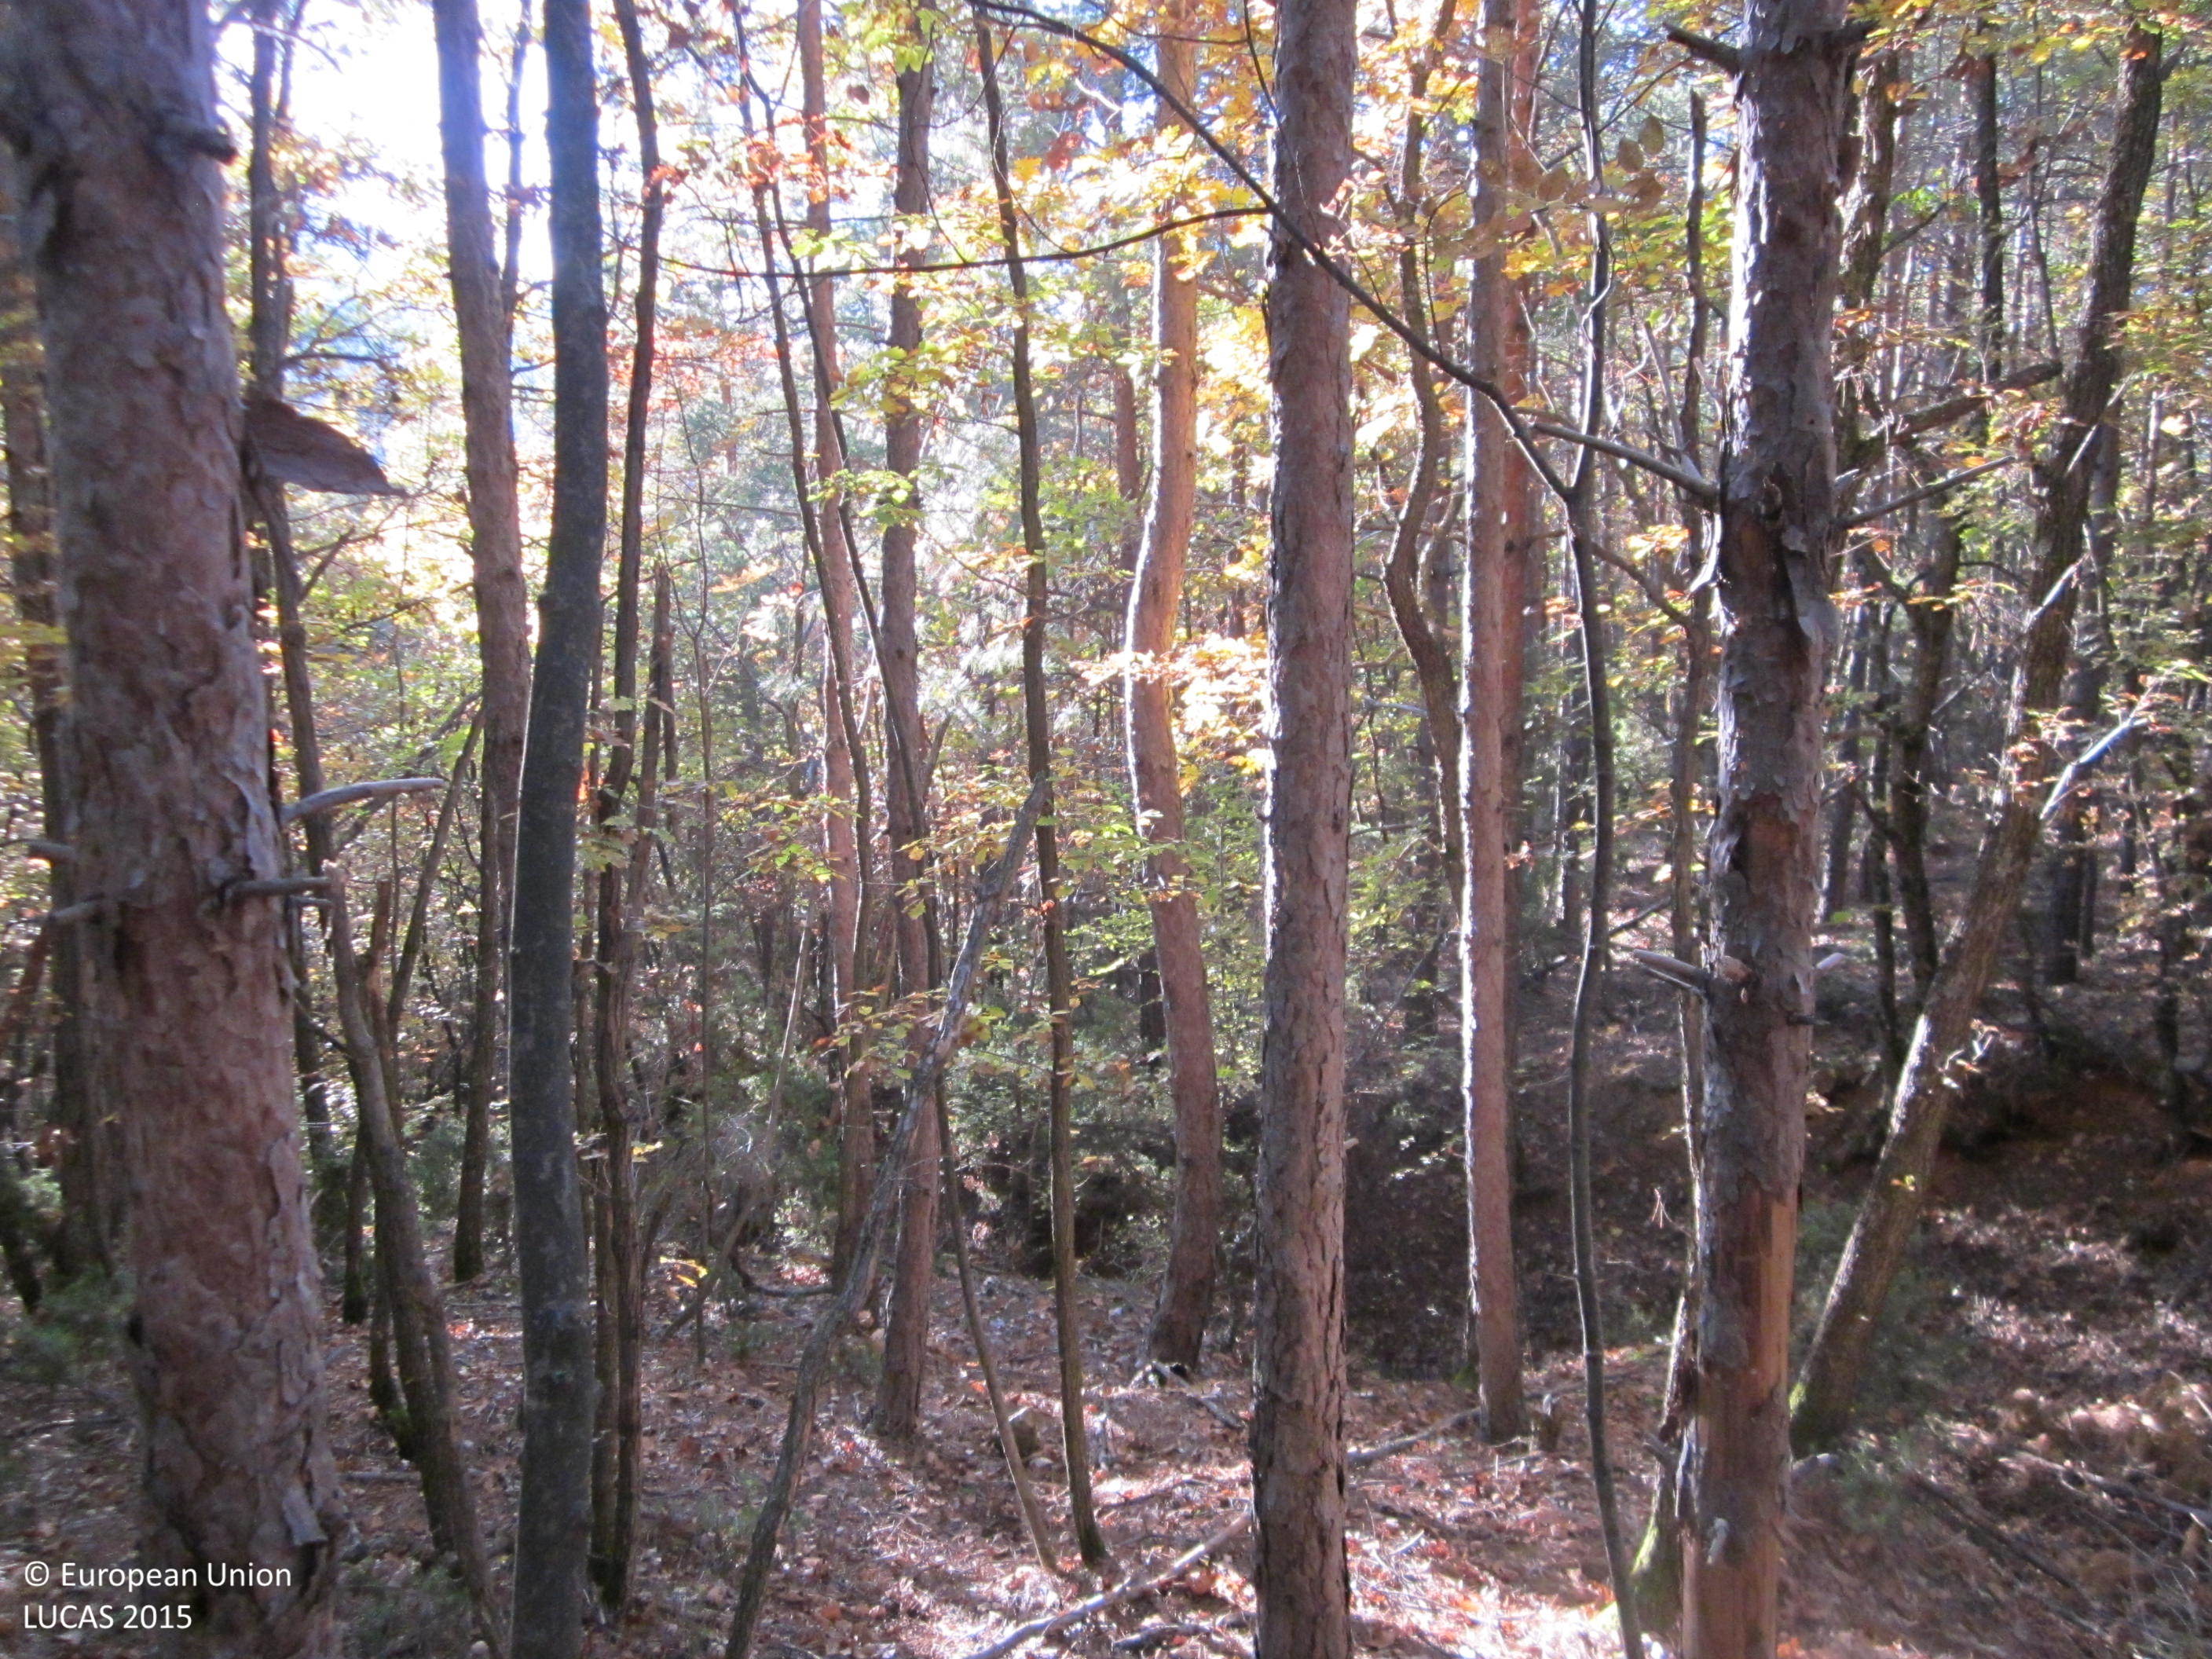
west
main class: Woodland
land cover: Pine dominated mixed woodland
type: hemiboreal forest and nemoral coniferous forest and mixed broadleaved-coniferous forest
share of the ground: > 75 %
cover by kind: coniferous forest trees 60 %, broadleaved forest trees 20 %, unconsolidated bare surface 15 %, lichens and mosses 5 %
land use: Forestry
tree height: > 5 m
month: November
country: BG
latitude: 41.5621
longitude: 25.7352
